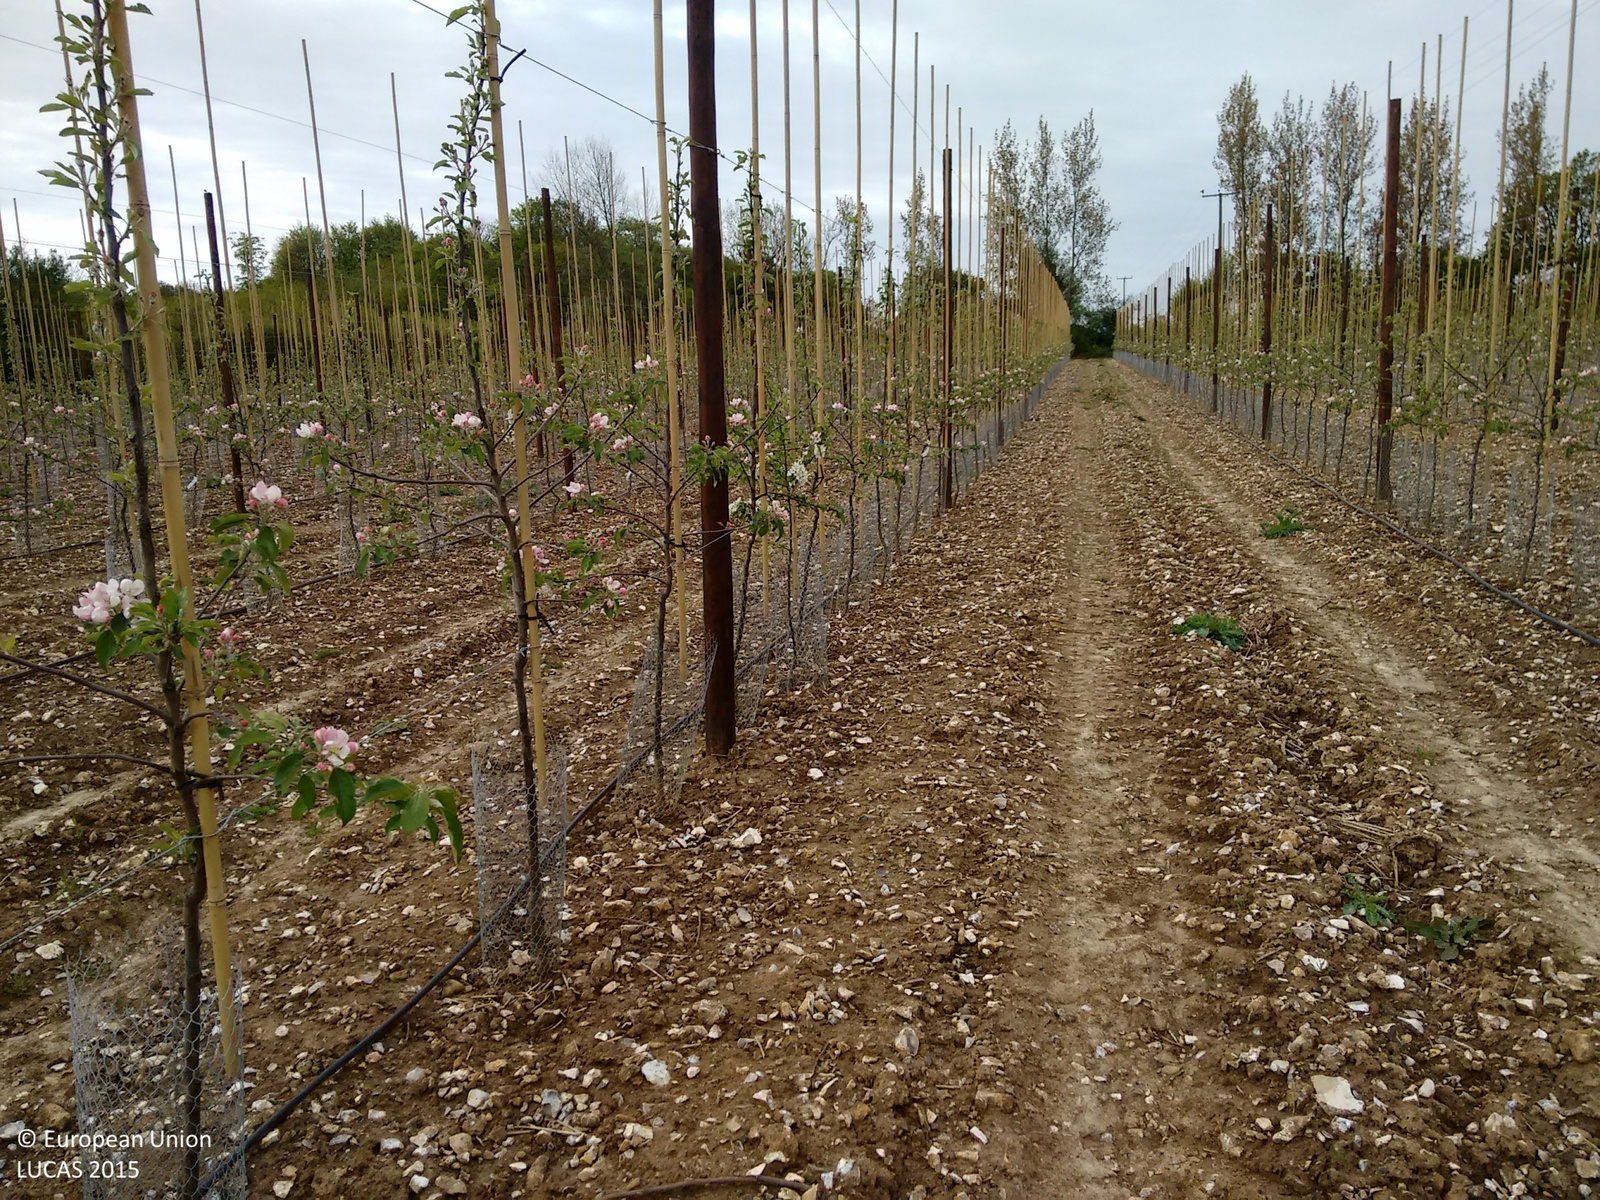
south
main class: Cropland
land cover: Apple fruit
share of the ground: 10 - 25 %
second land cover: Other bare soil
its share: > 75 %
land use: Agriculture (excluding fallow land and kitchen gardens)
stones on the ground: 25 - 50 %
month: May
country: GB
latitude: 51.2897
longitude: 0.7253
